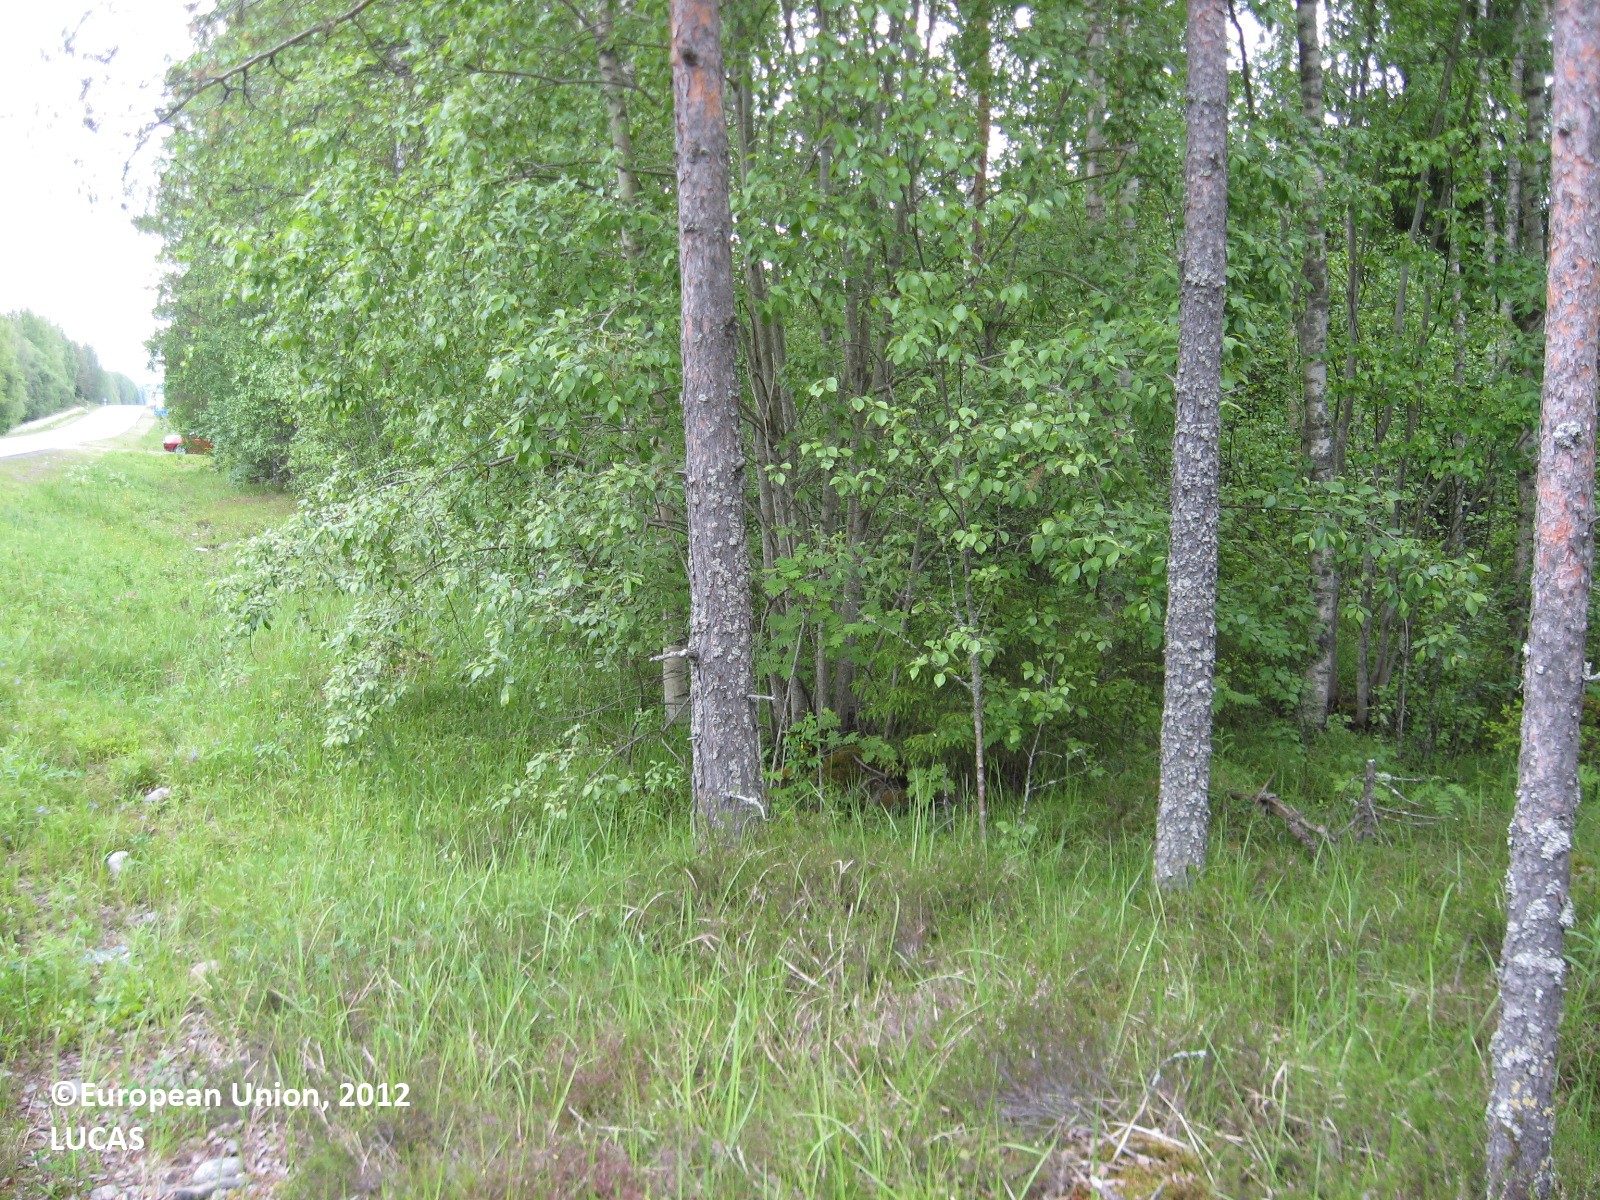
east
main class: Woodland
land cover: Spruce dominated mixed woodland
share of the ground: > 75 %
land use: Forestry
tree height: > 5 m
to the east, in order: Spruce dominated mixed woodland; Grassland without tree/shrub cover; Other mixed woodland; Pine dominated coniferous woodland; Other mixed woodland
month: June
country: FI
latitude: 62.9826
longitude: 21.6236
